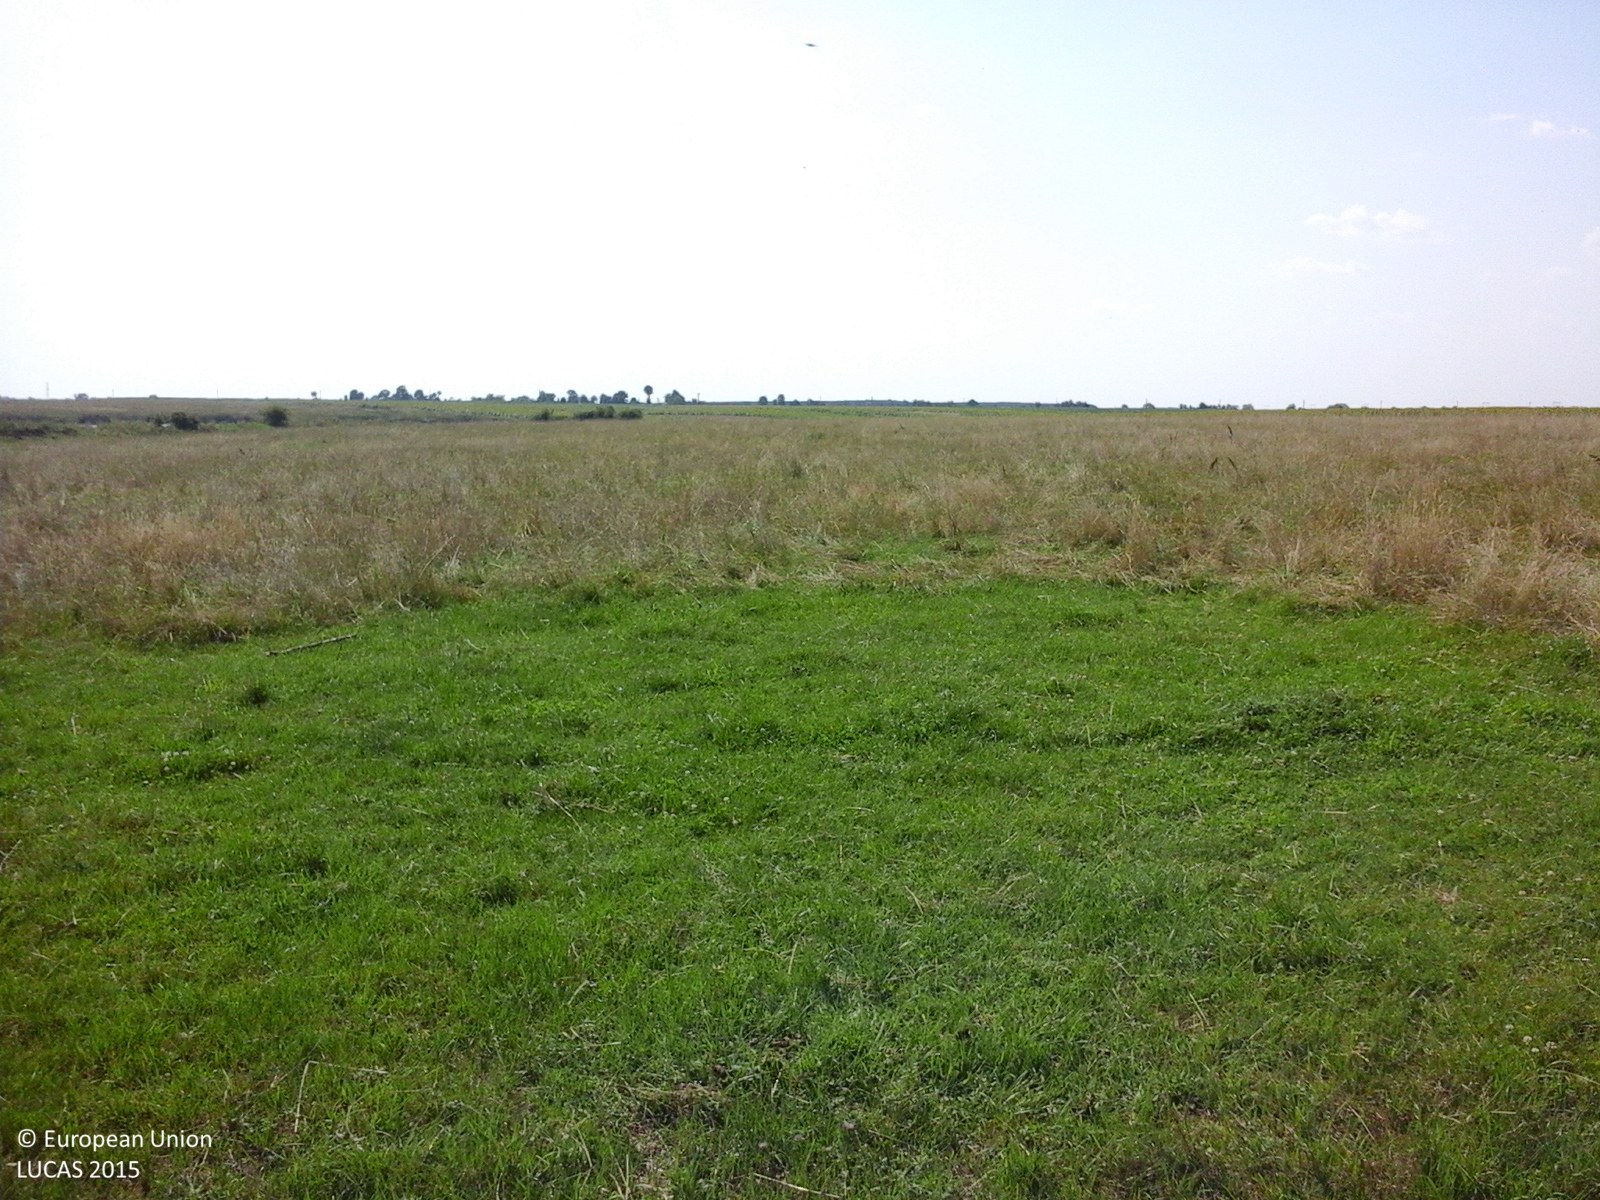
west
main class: Grassland
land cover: Grassland without tree/shrub cover
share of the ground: > 75 %
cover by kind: herbaceous plants 100 %
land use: Agriculture (excluding fallow land and kitchen gardens)
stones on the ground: < 10 %
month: July
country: RO
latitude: 44.5961
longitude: 24.9590
